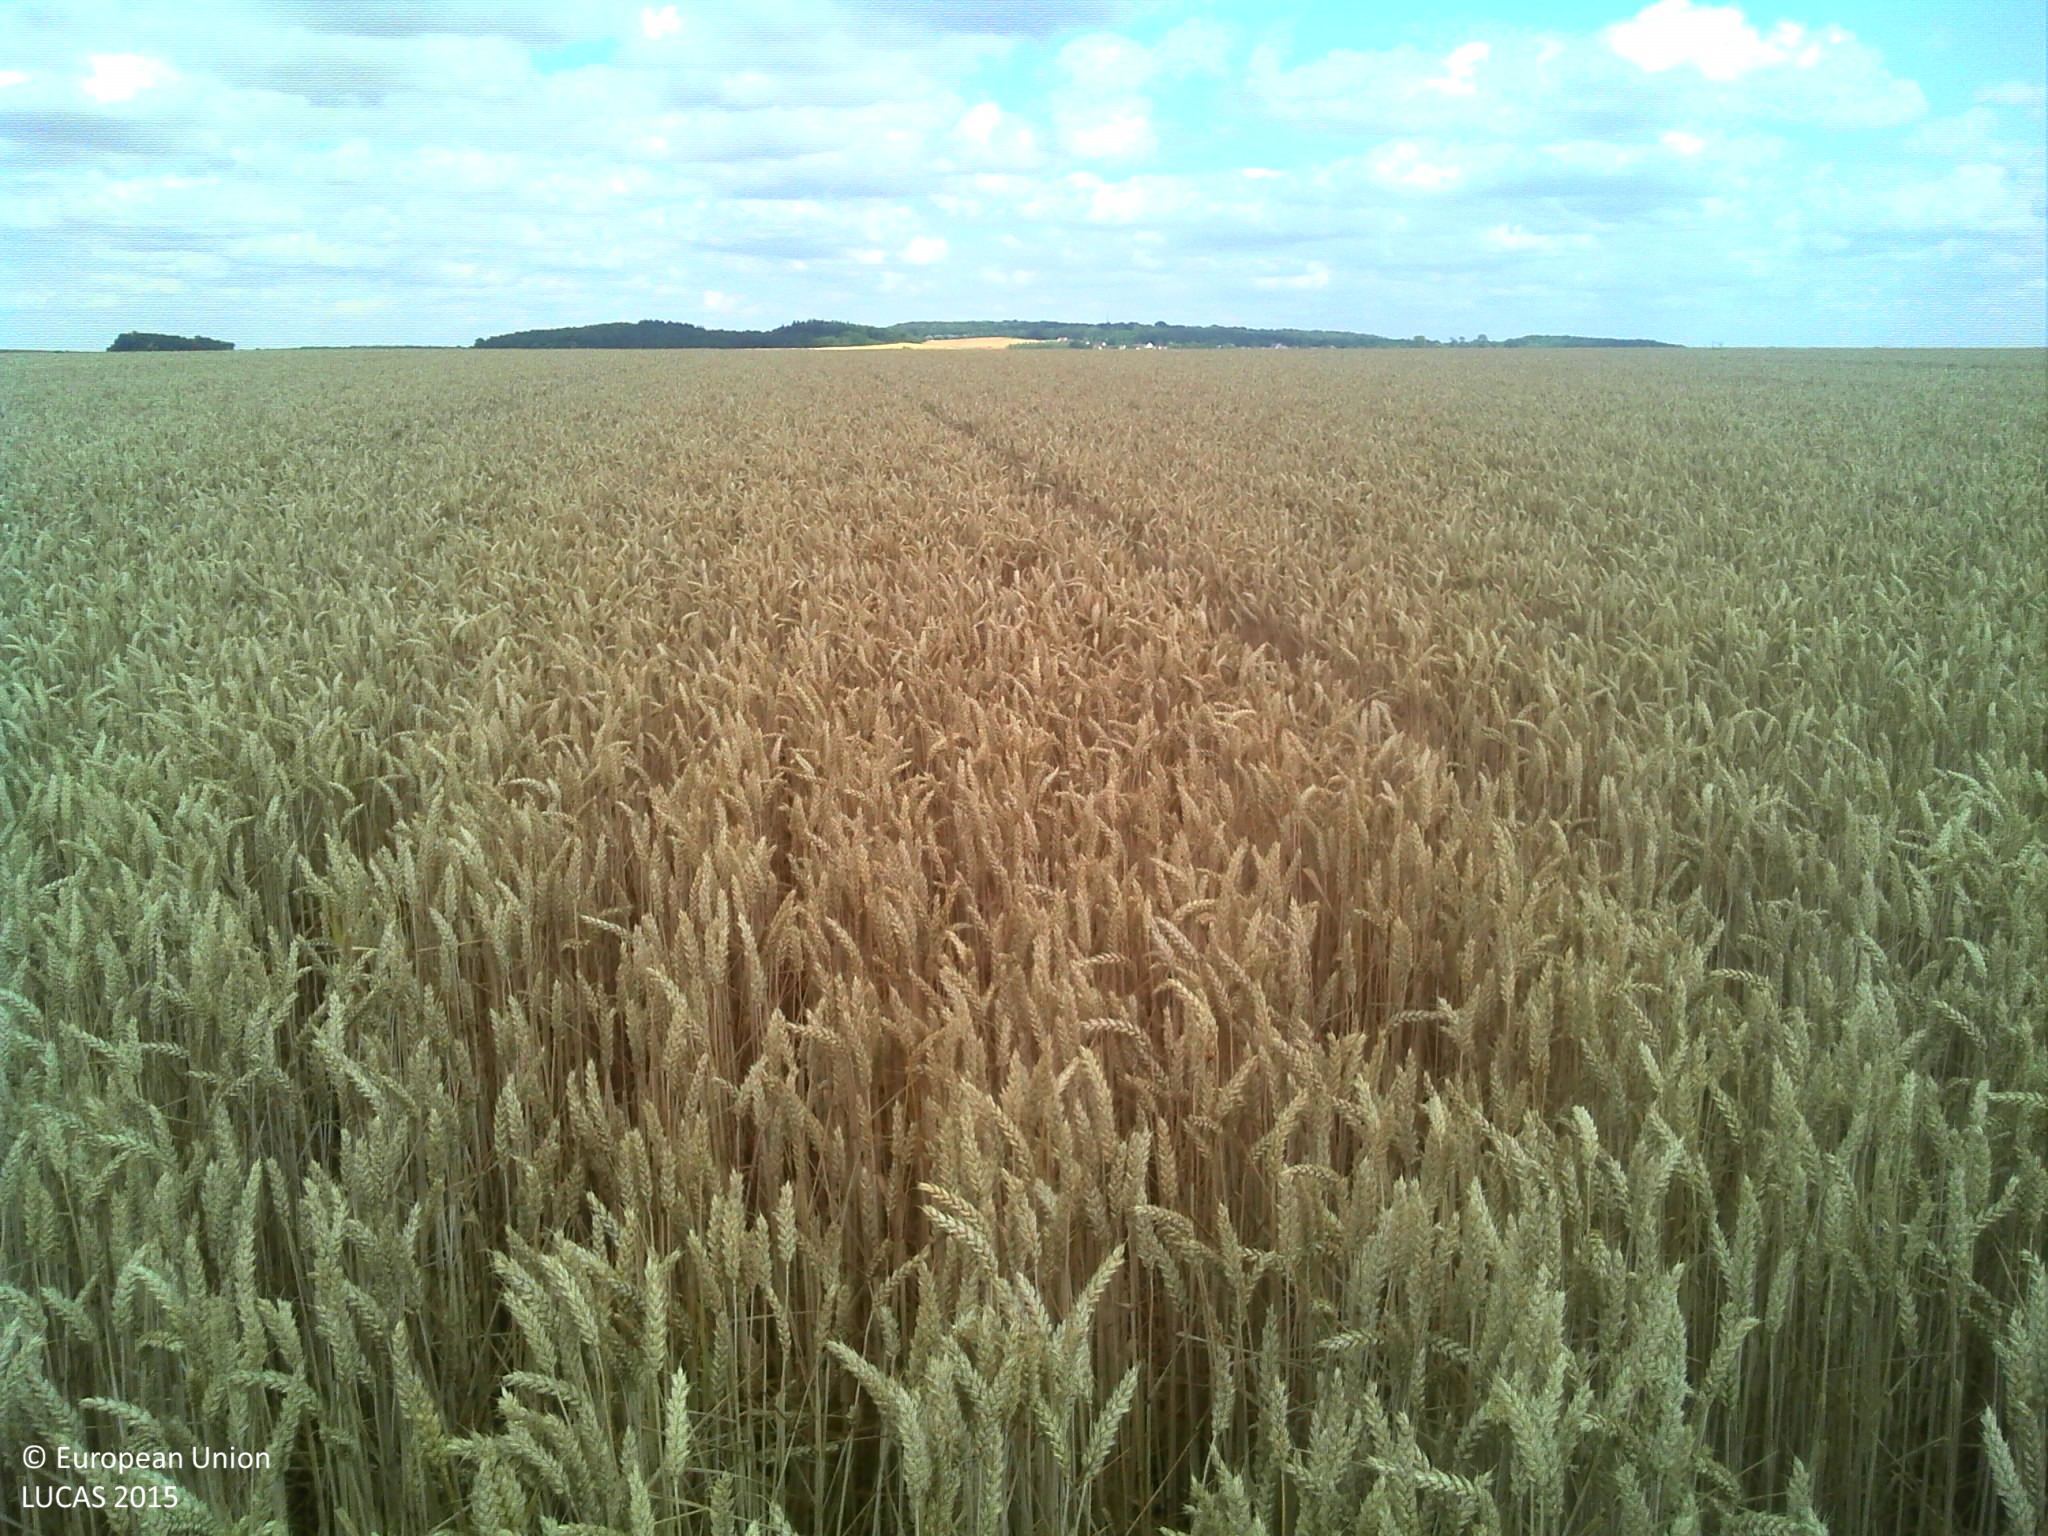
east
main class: Cropland
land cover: Common wheat
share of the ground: > 75 %
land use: Agriculture (excluding fallow land and kitchen gardens)
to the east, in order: Common wheat
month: July
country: FR
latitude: 49.2831
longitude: 3.2973
